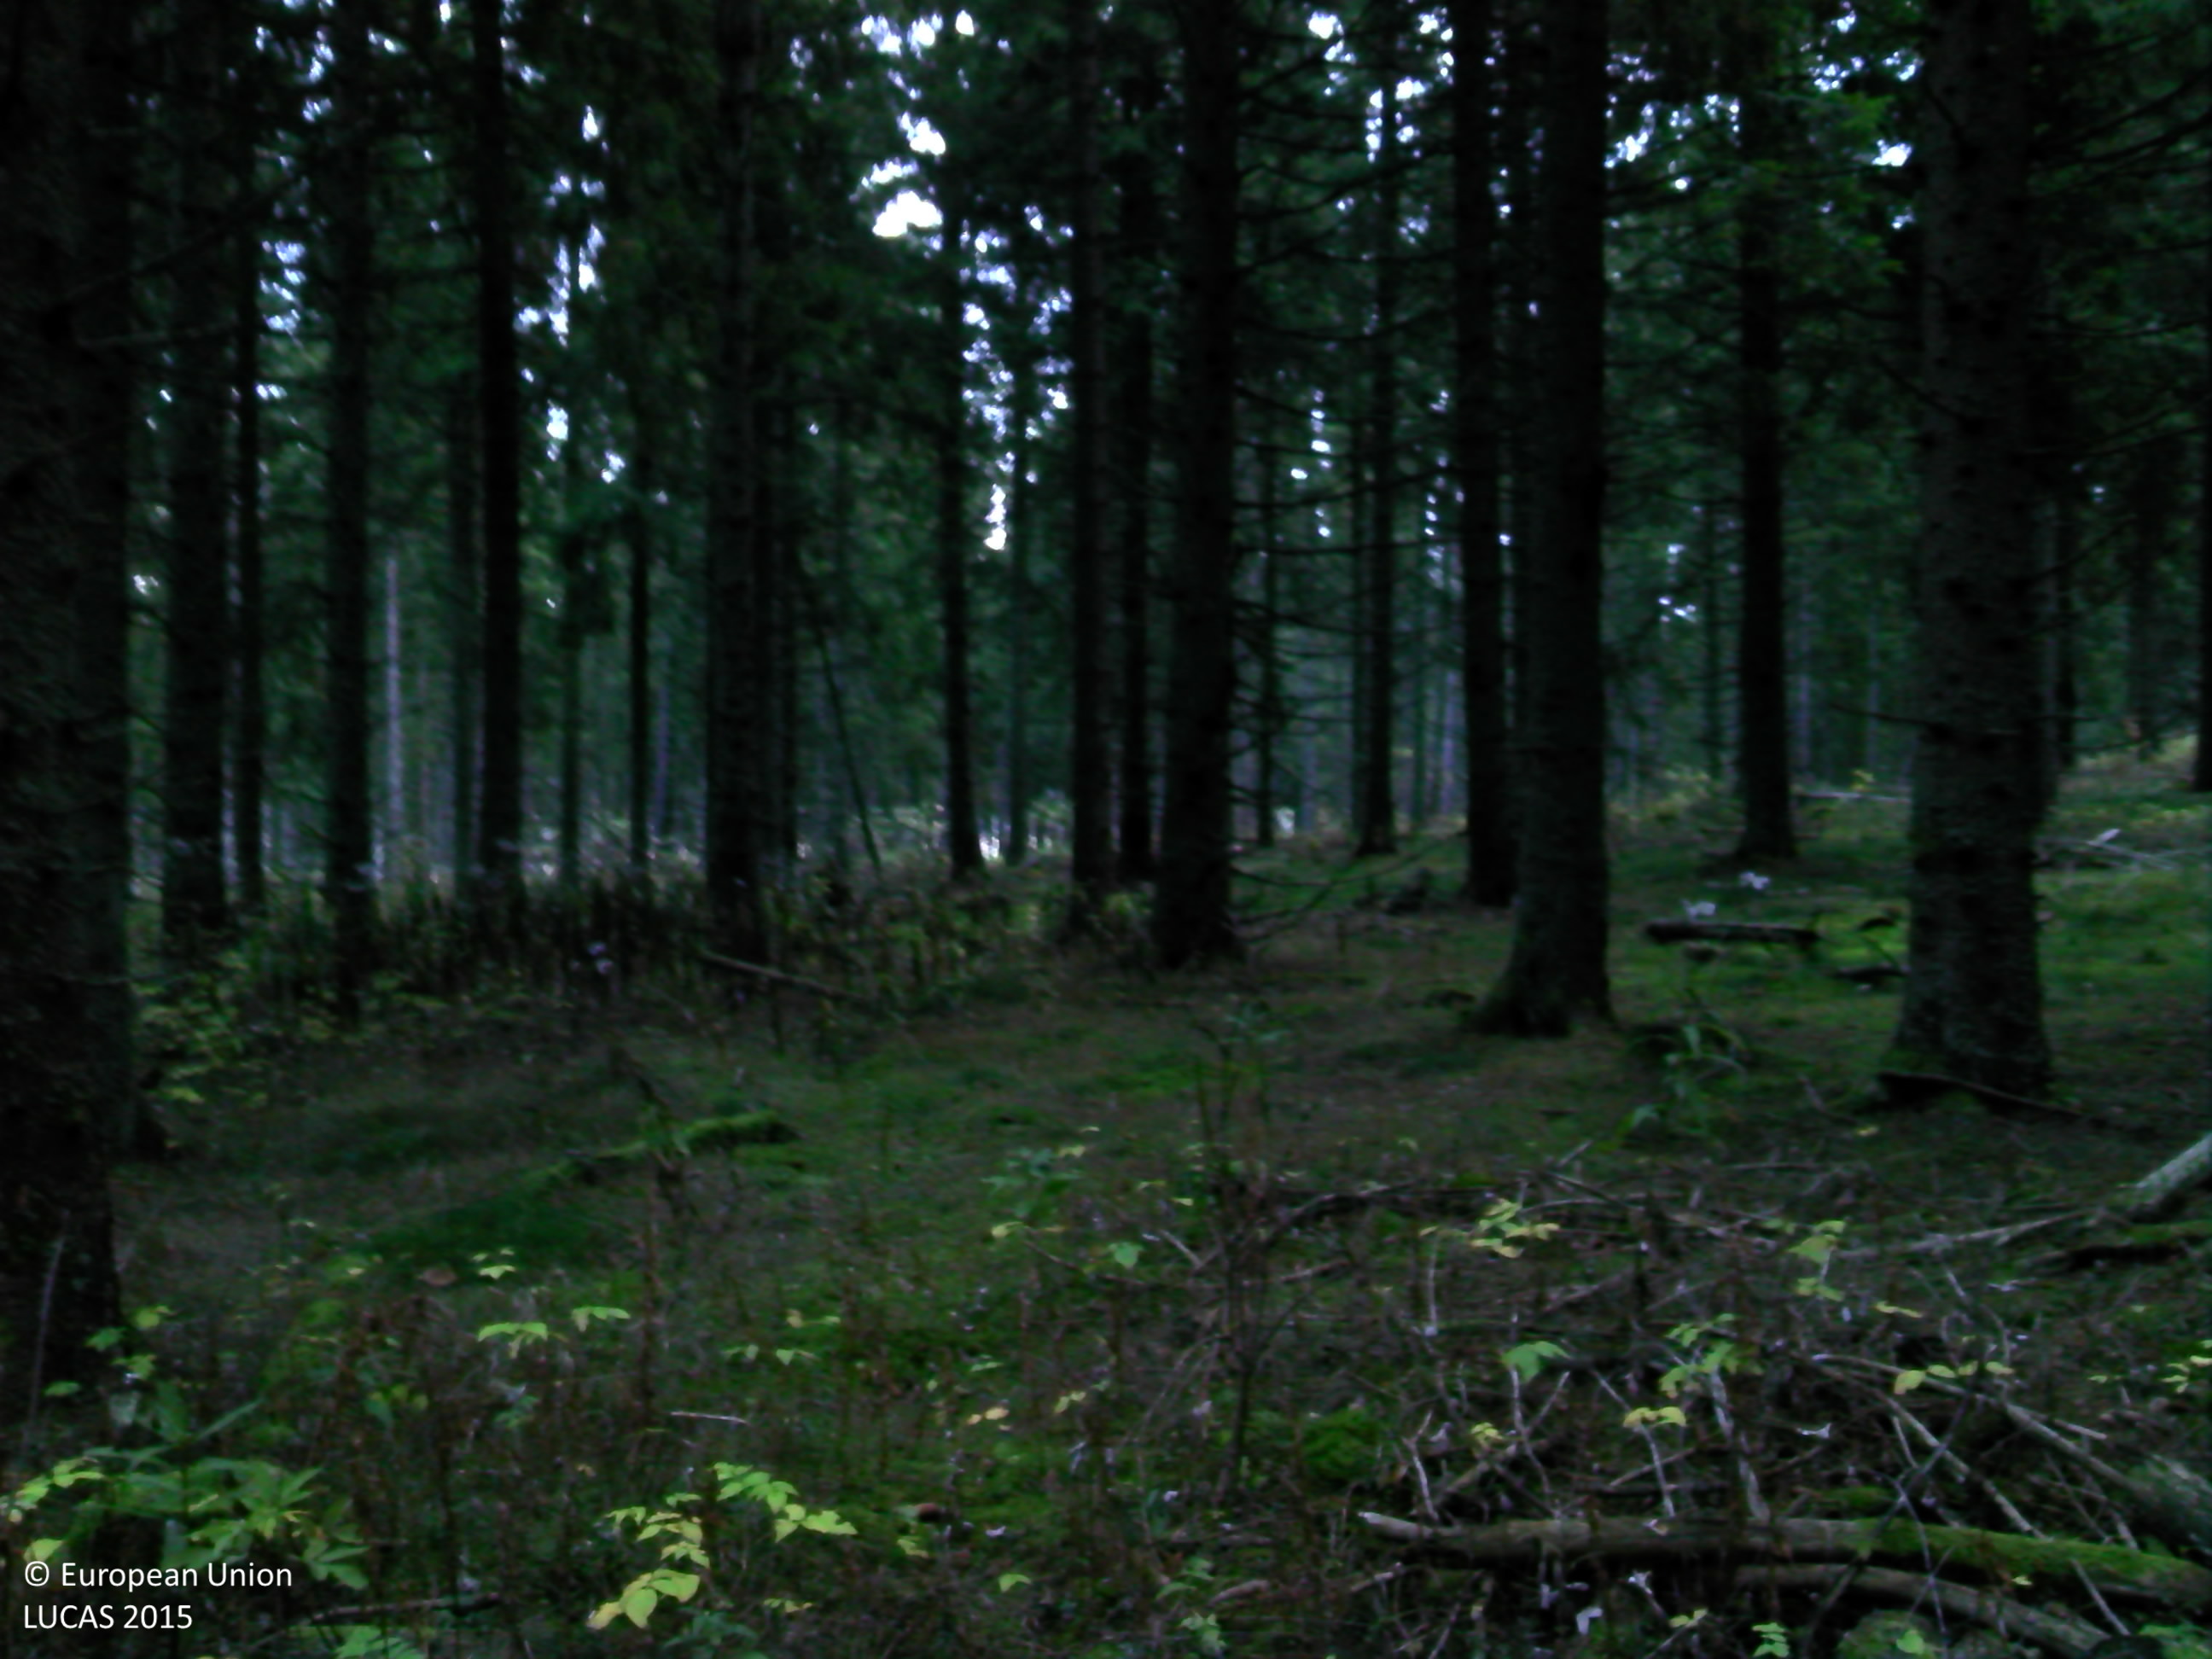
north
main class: Woodland
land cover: Spruce dominated coniferous woodland
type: exotic forest
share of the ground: > 75 %
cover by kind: coniferous forest trees 80 %, shrubs 10 %, herbaceous plants 5 %, lichens and mosses 5 %
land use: Forestry
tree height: > 5 m
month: October
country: FR
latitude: 44.7679
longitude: 3.9024
